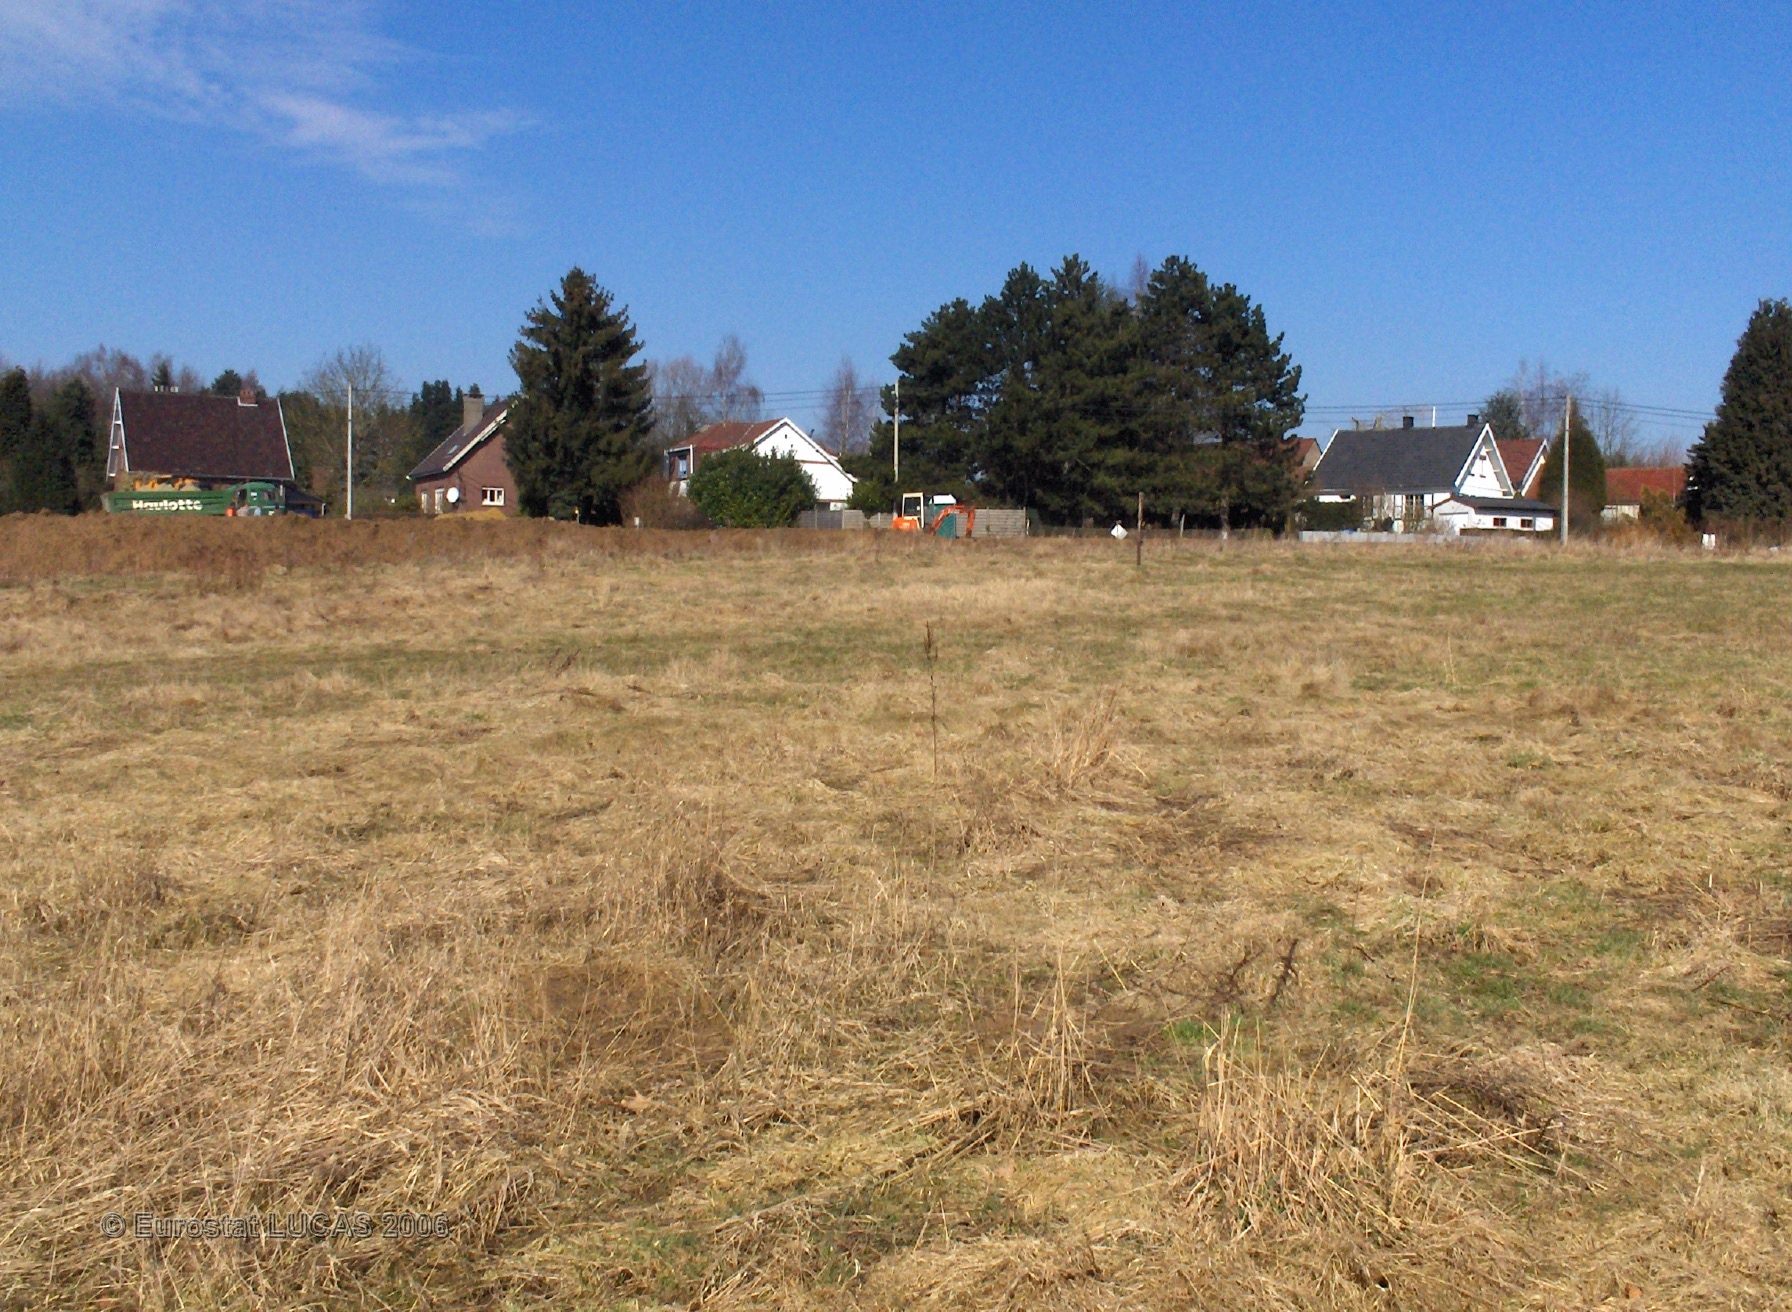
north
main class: Grassland
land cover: Grassland without tree/shrub cover
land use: Agriculture (excluding fallow land and kitchen gardens)
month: March
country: BE
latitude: 50.7011
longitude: 4.5164
